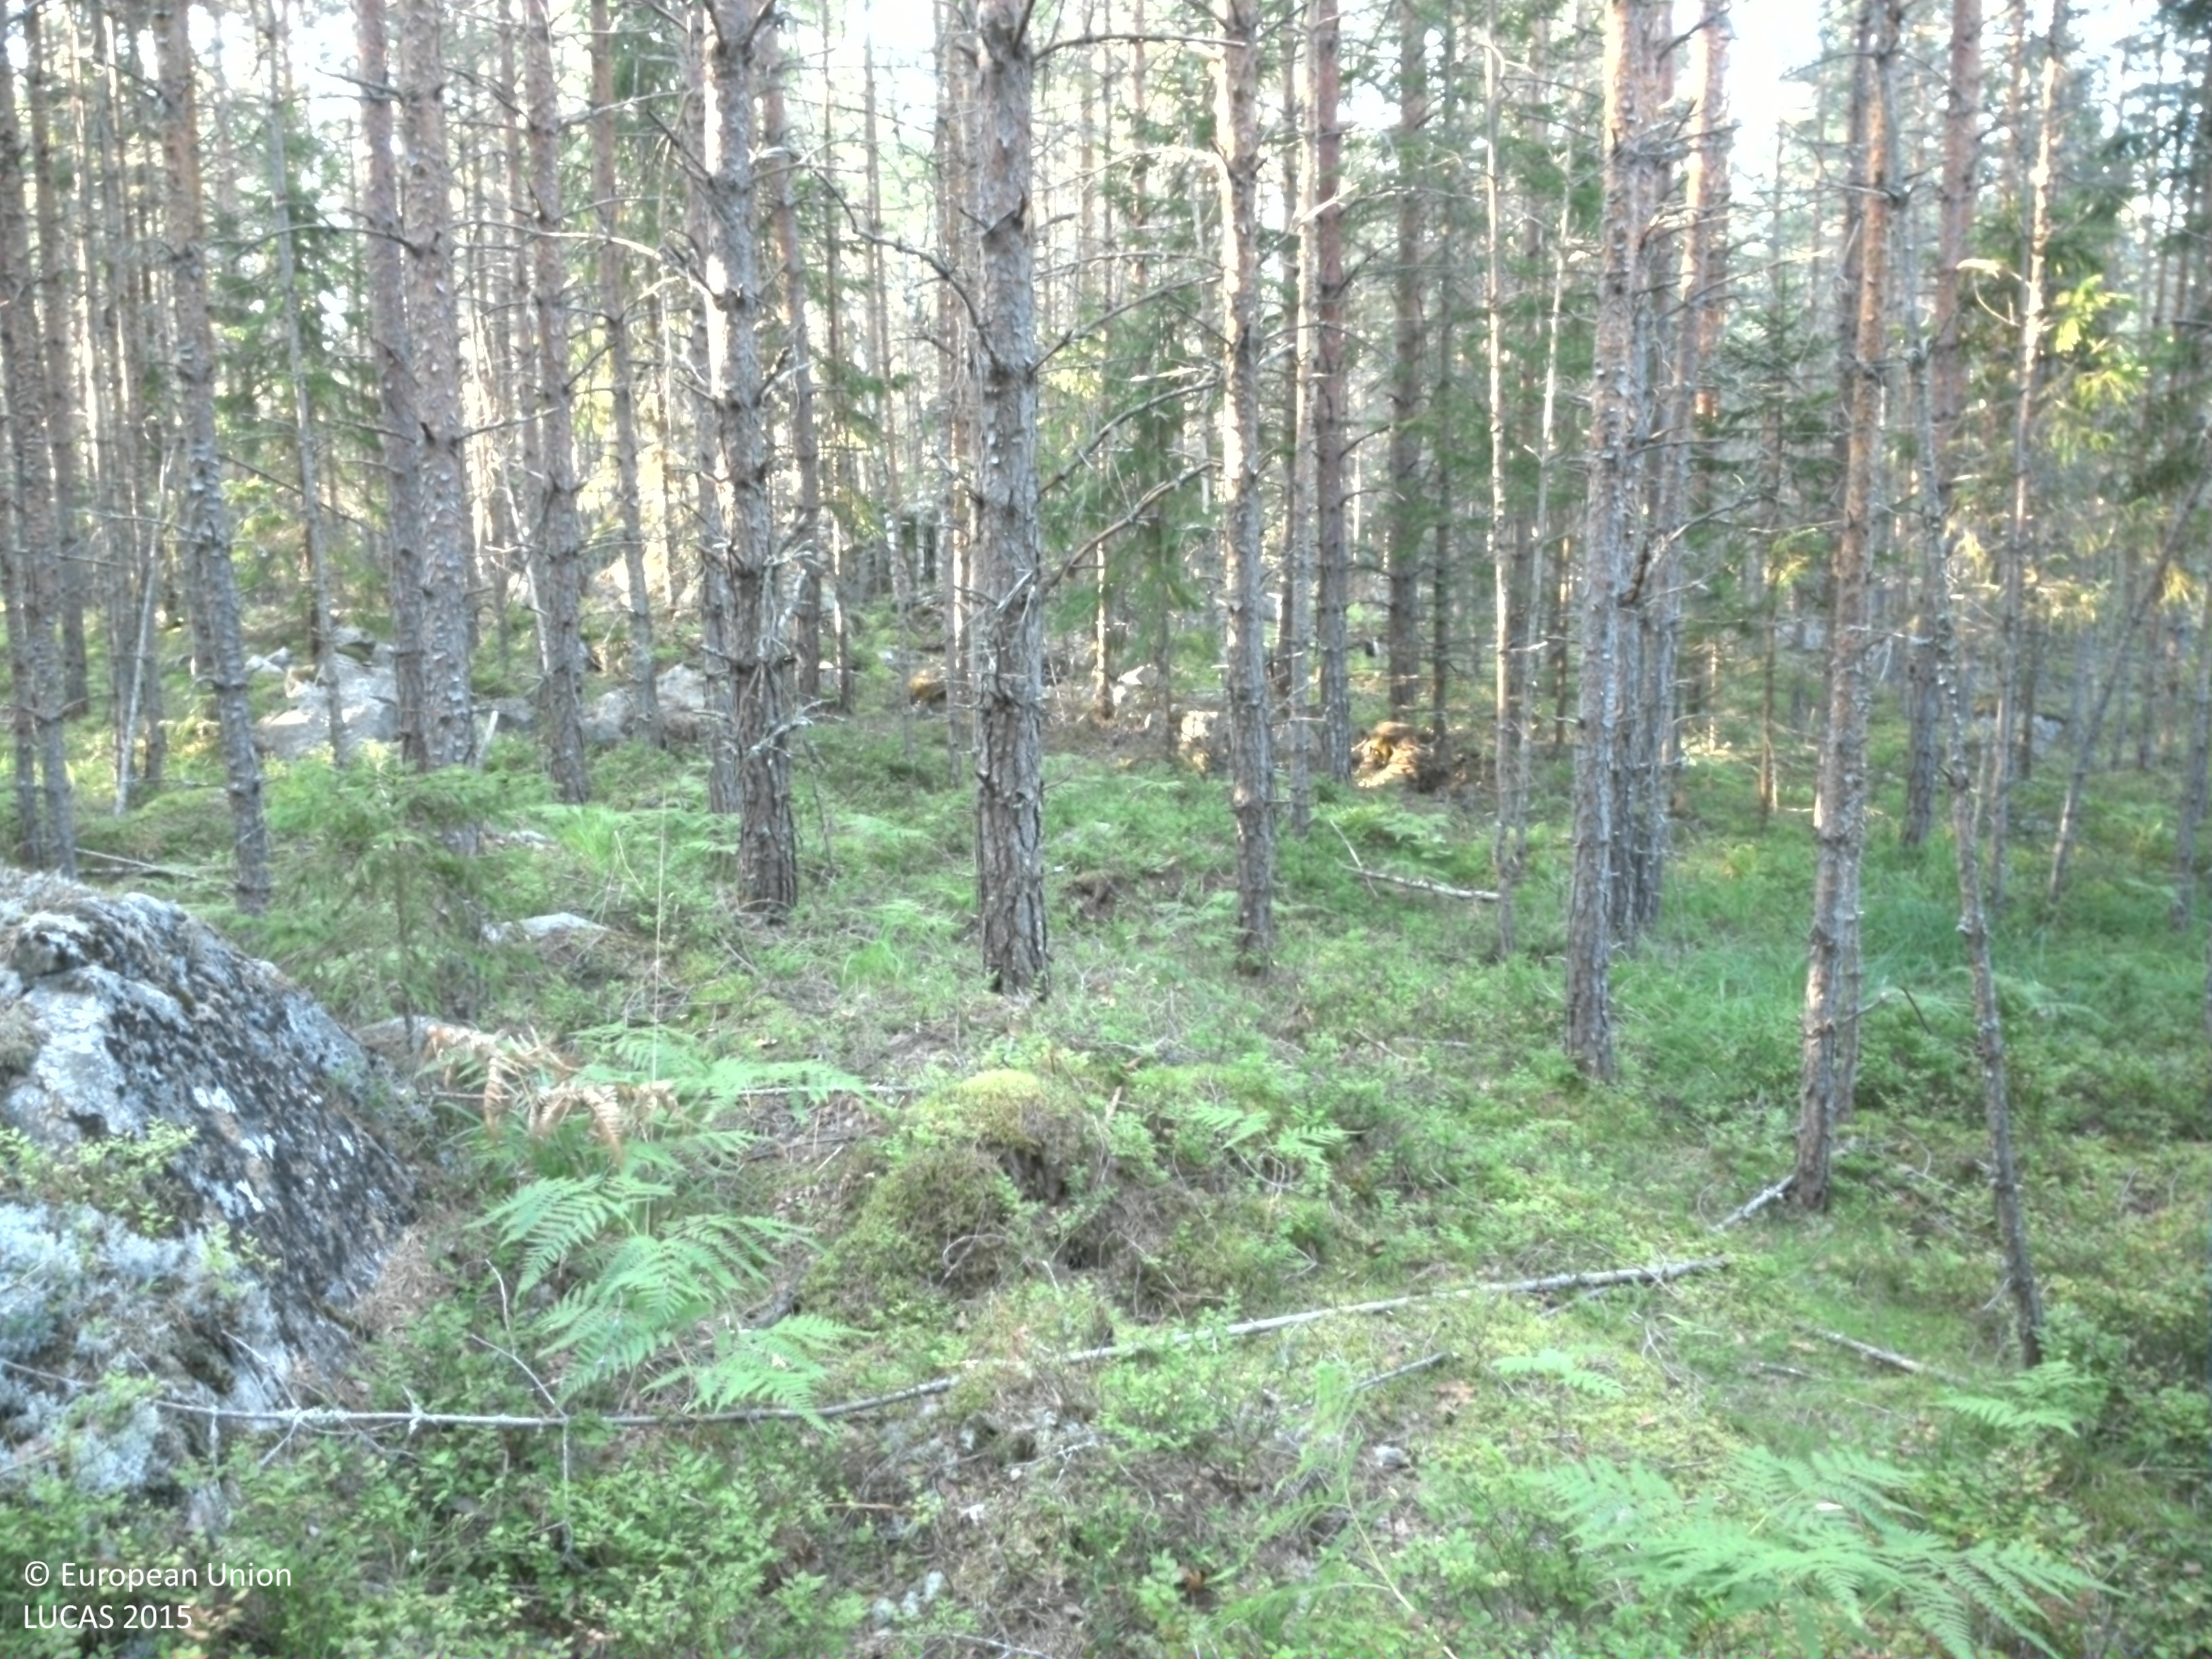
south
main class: Woodland
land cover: Pine dominated coniferous woodland
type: boreal forest
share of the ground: > 75 %
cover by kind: coniferous forest trees 75 %, lichens and mosses 15 %, shrubs 10 %
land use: Forestry
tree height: > 5 m
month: August
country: SE
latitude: 59.7287
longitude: 15.9843
